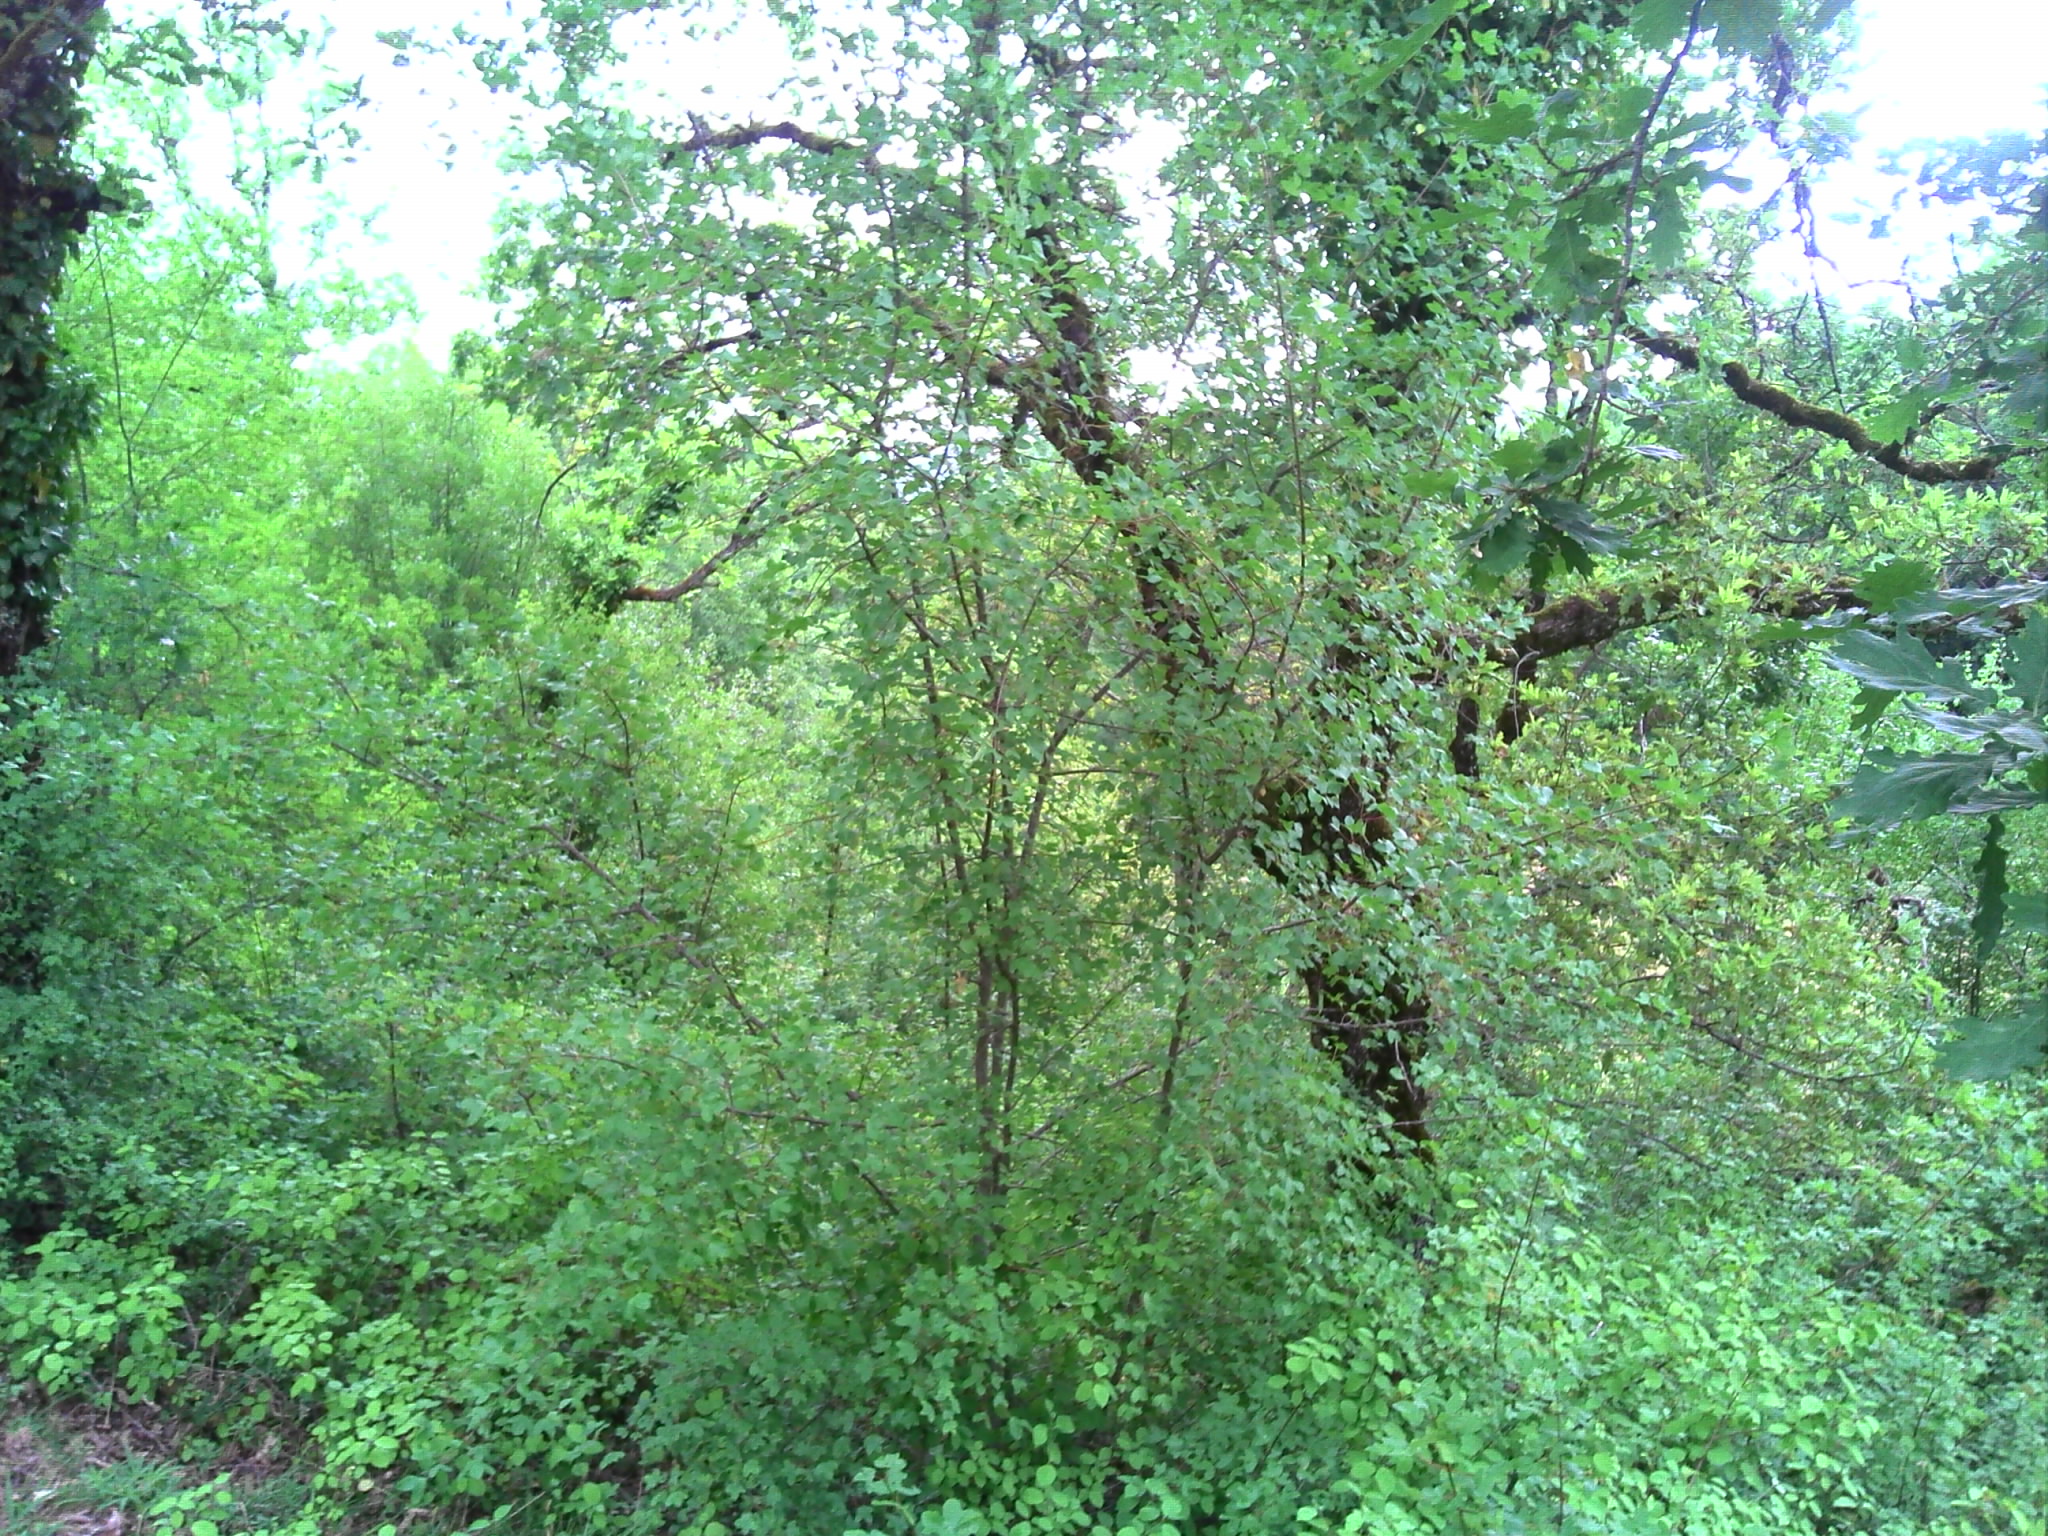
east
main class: Woodland
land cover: Broadleaved woodland
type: thermophilous deciduous forest
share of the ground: 50 - 75 %
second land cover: Grassland without tree/shrub cover
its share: 25 - 50 %
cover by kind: broadleaved forest trees 80 %, herbaceous plants 20 %
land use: Forestry
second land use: Agriculture (excluding fallow land and kitchen gardens)
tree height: > 5 m
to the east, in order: Broadleaved woodland; Grassland without tree/shrub cover; Broadleaved woodland; Fences; Dry stone walls; Tracks; Broadleaved woodland; Dry stone walls; Other bare soil; Broadleaved woodland
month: June
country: FR
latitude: 44.4280
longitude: 1.8478
